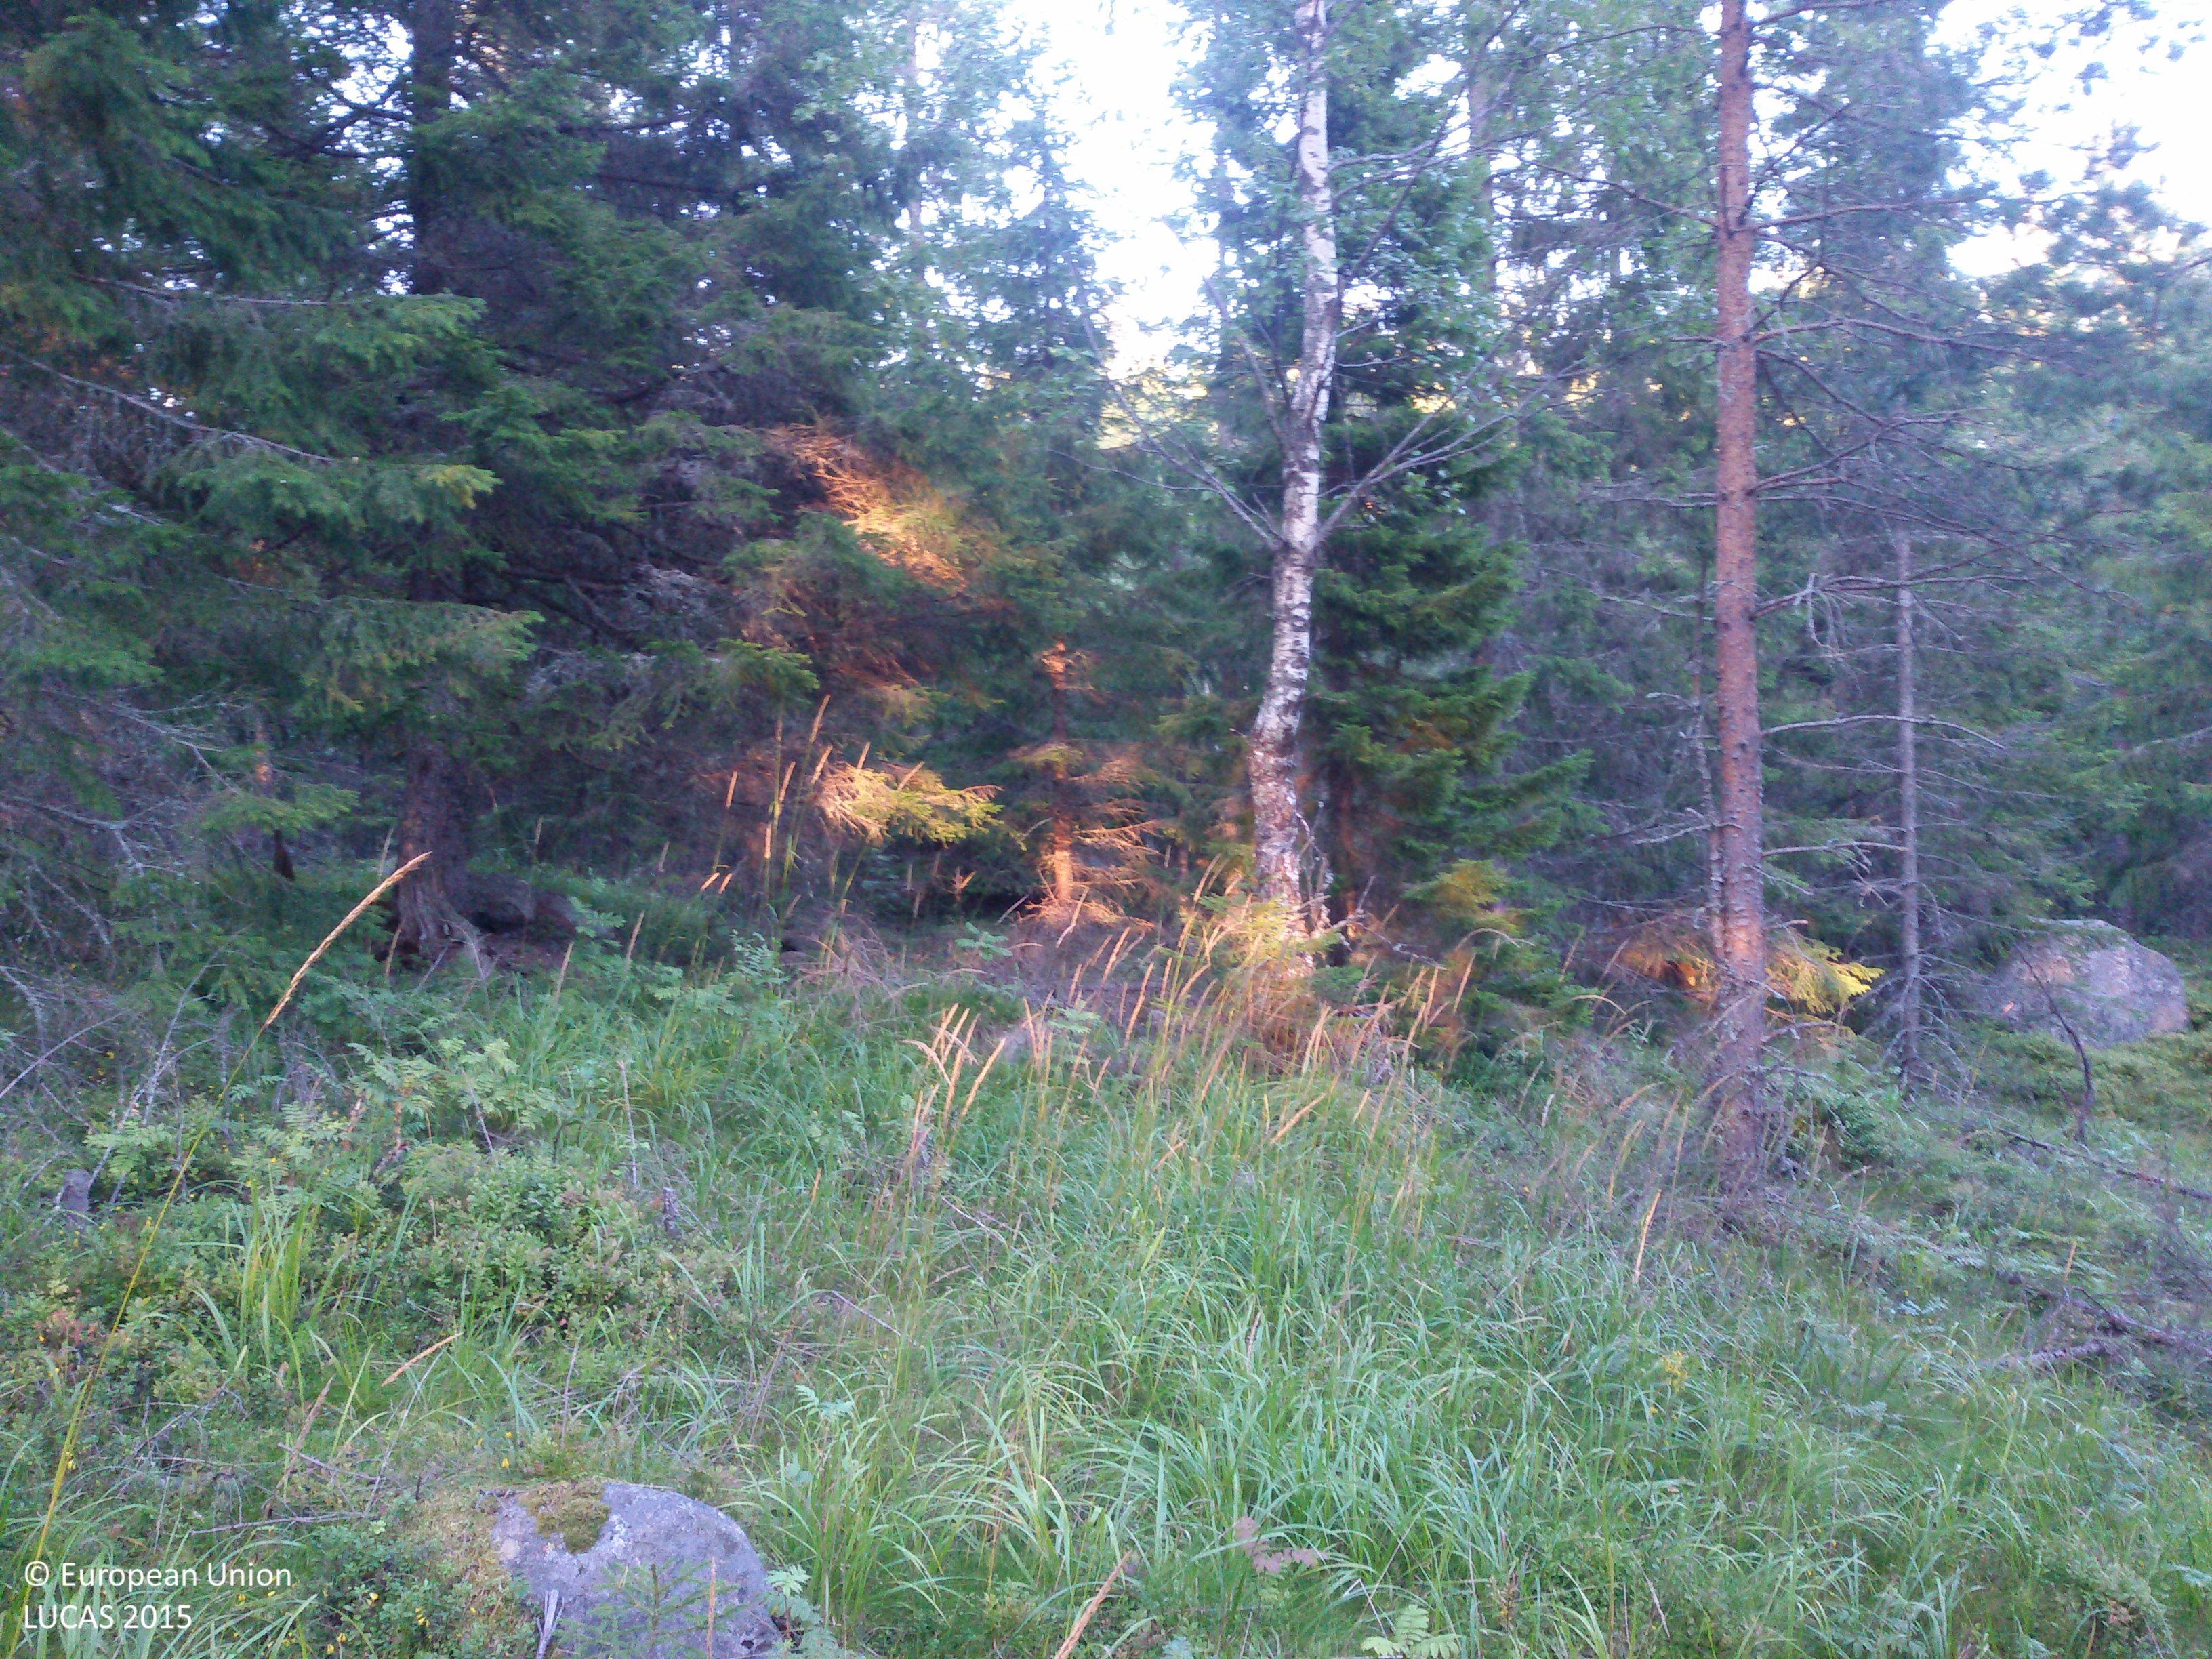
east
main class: Woodland
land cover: Other coniferous woodland
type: boreal forest
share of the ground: 50 - 75 %
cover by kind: coniferous forest trees 60 %, herbaceous plants 25 %, lichens and mosses 15 %
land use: Forestry
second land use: Other primary production
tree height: > 5 m
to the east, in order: Other coniferous woodland; Paved roads, cycling and walking lanes; Pine dominated coniferous woodland
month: August
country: SE
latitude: 60.7862
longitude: 16.5814
